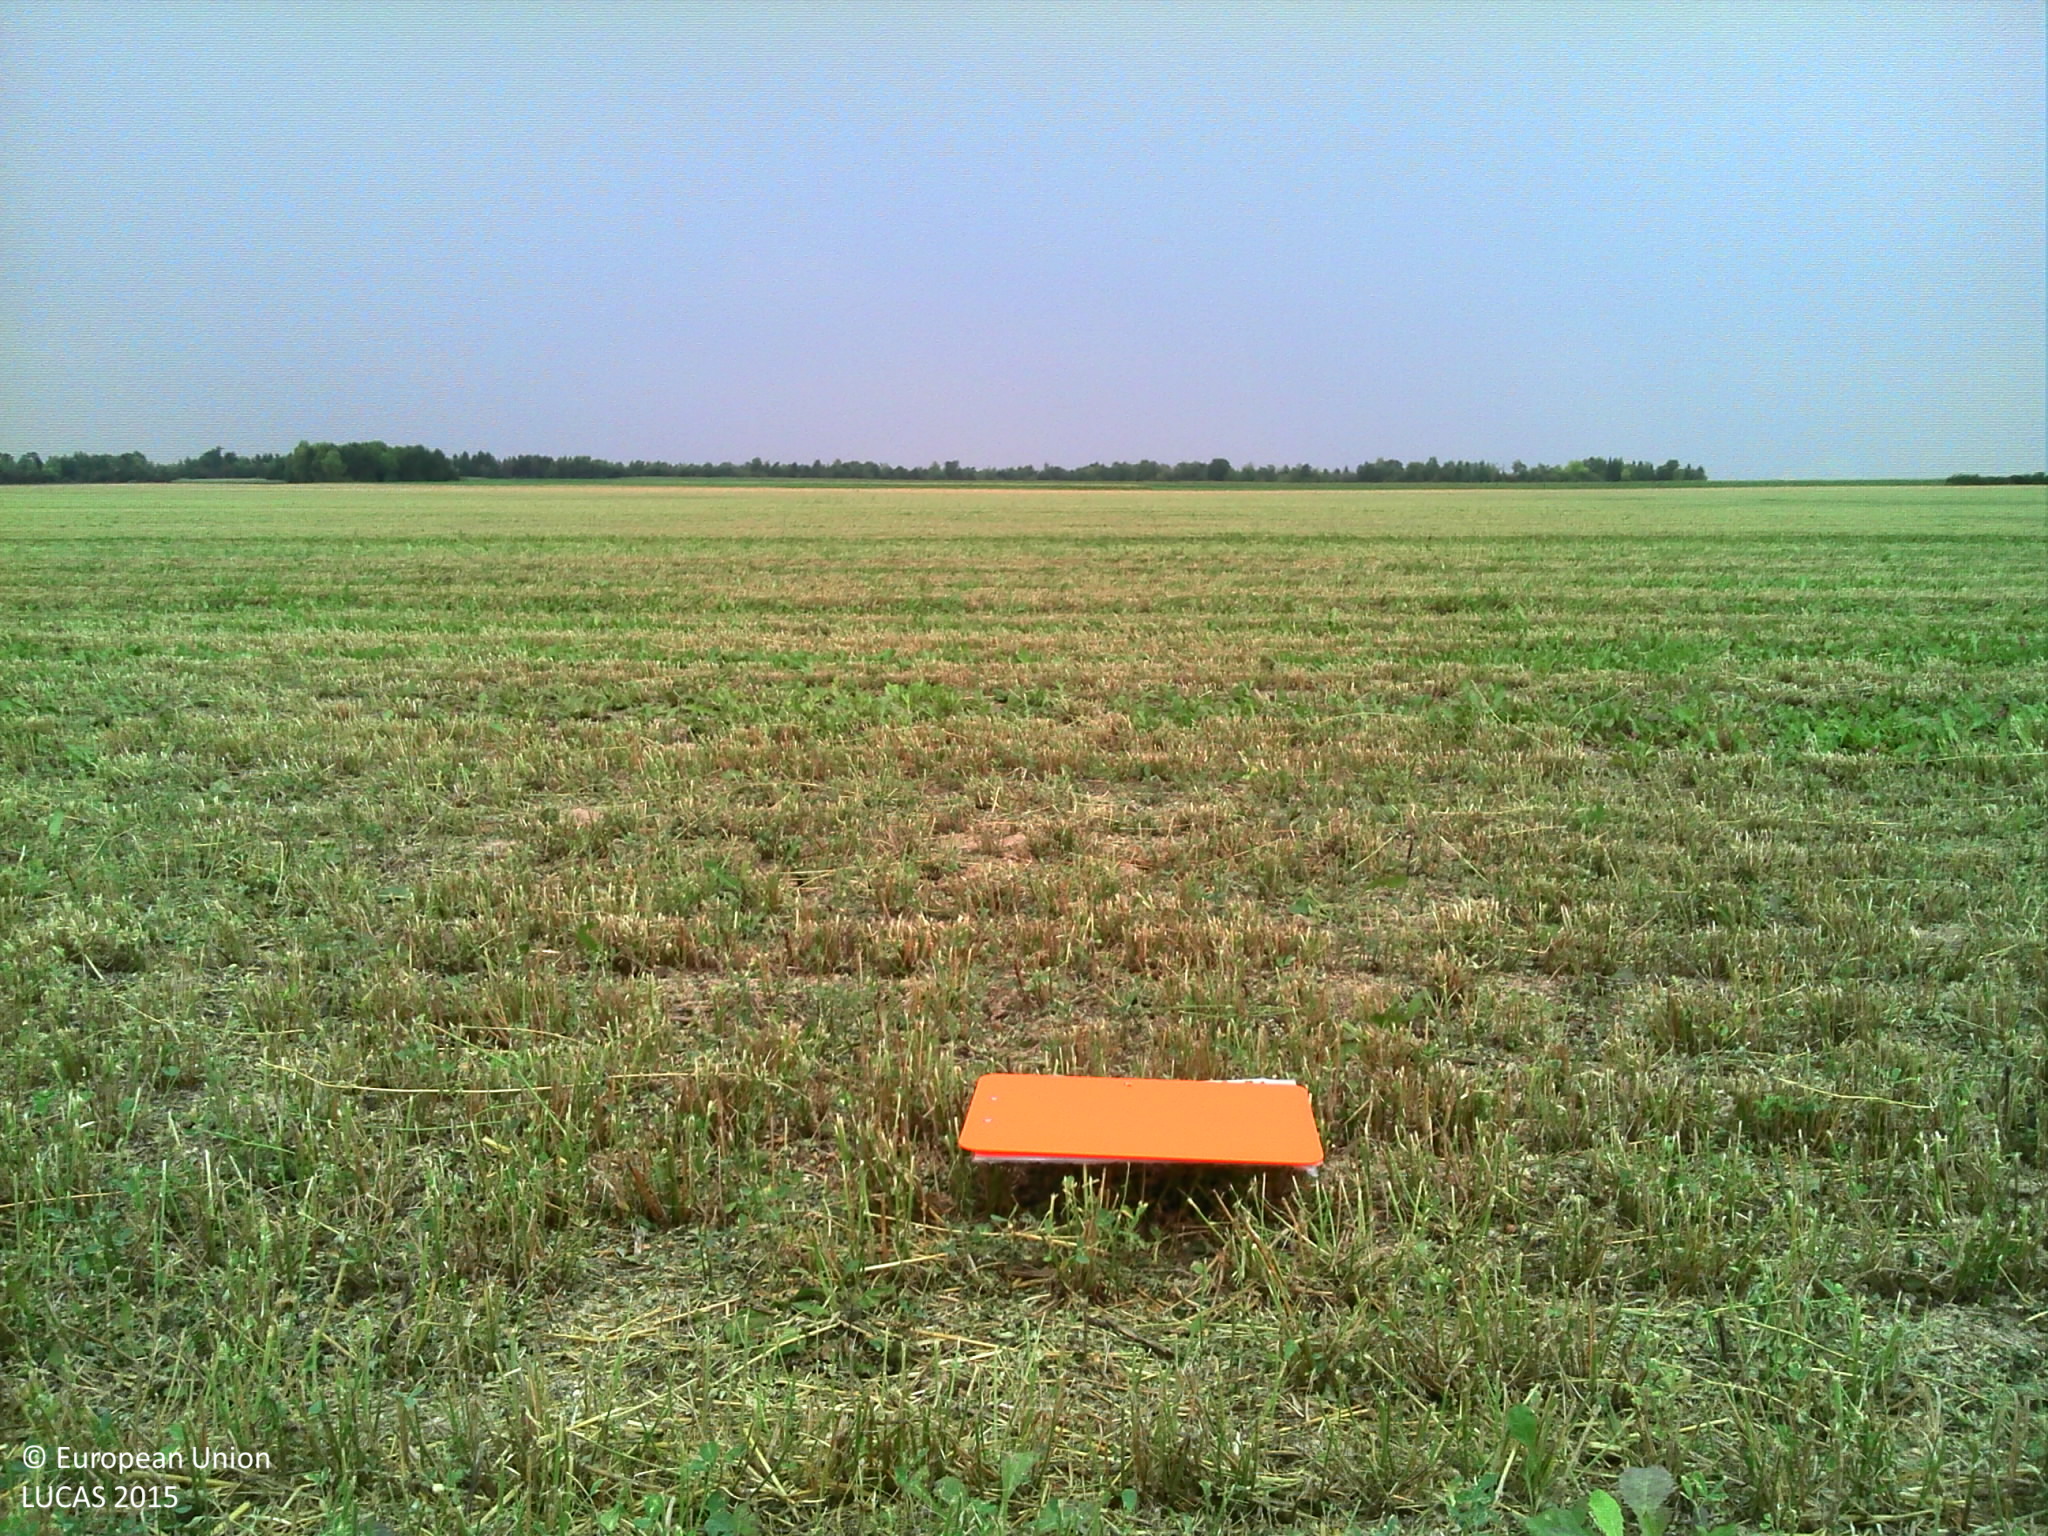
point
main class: Cropland
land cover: Lucerne
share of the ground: > 75 %
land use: Agriculture (excluding fallow land and kitchen gardens)
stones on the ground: < 10 %
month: August
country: FR
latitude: 48.6262
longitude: 3.7946
